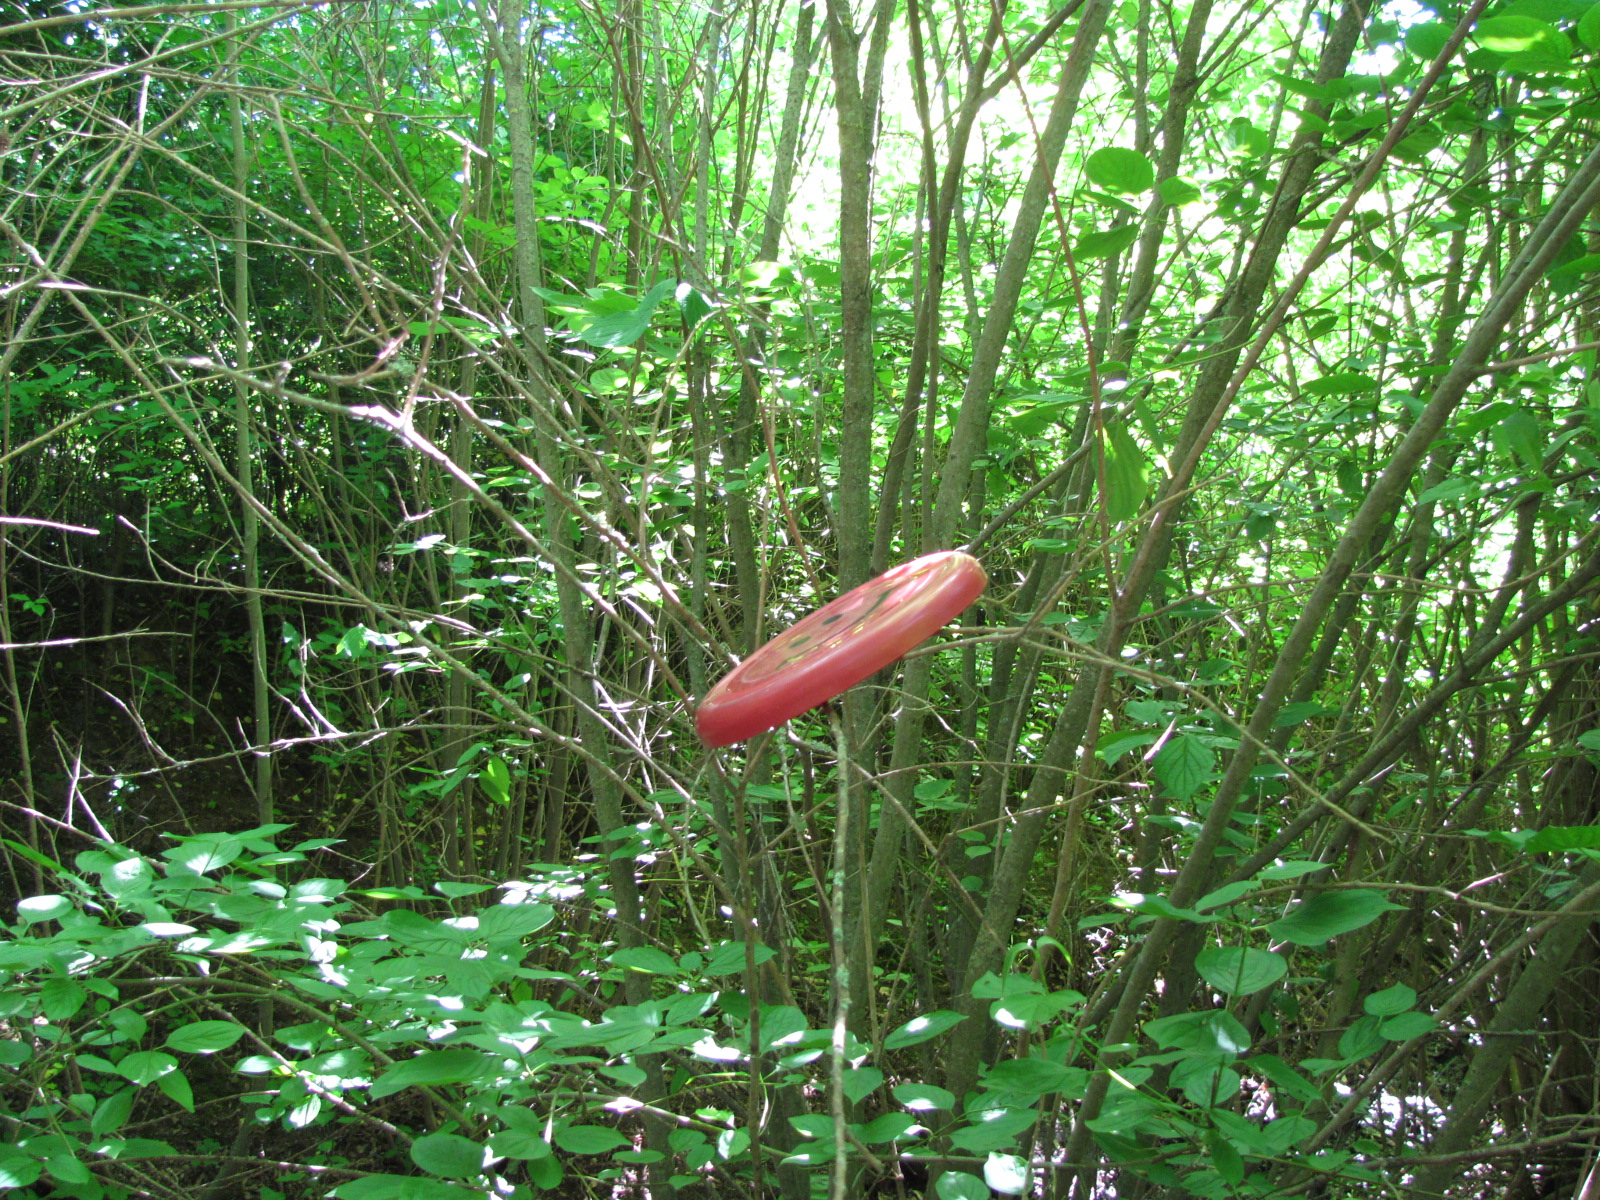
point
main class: Woodland
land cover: Broadleaved woodland
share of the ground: > 75 %
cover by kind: broadleaved forest trees 100 %
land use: Semi-natural and natural areas not in use
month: July
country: LV
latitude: 56.5067
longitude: 23.7114
